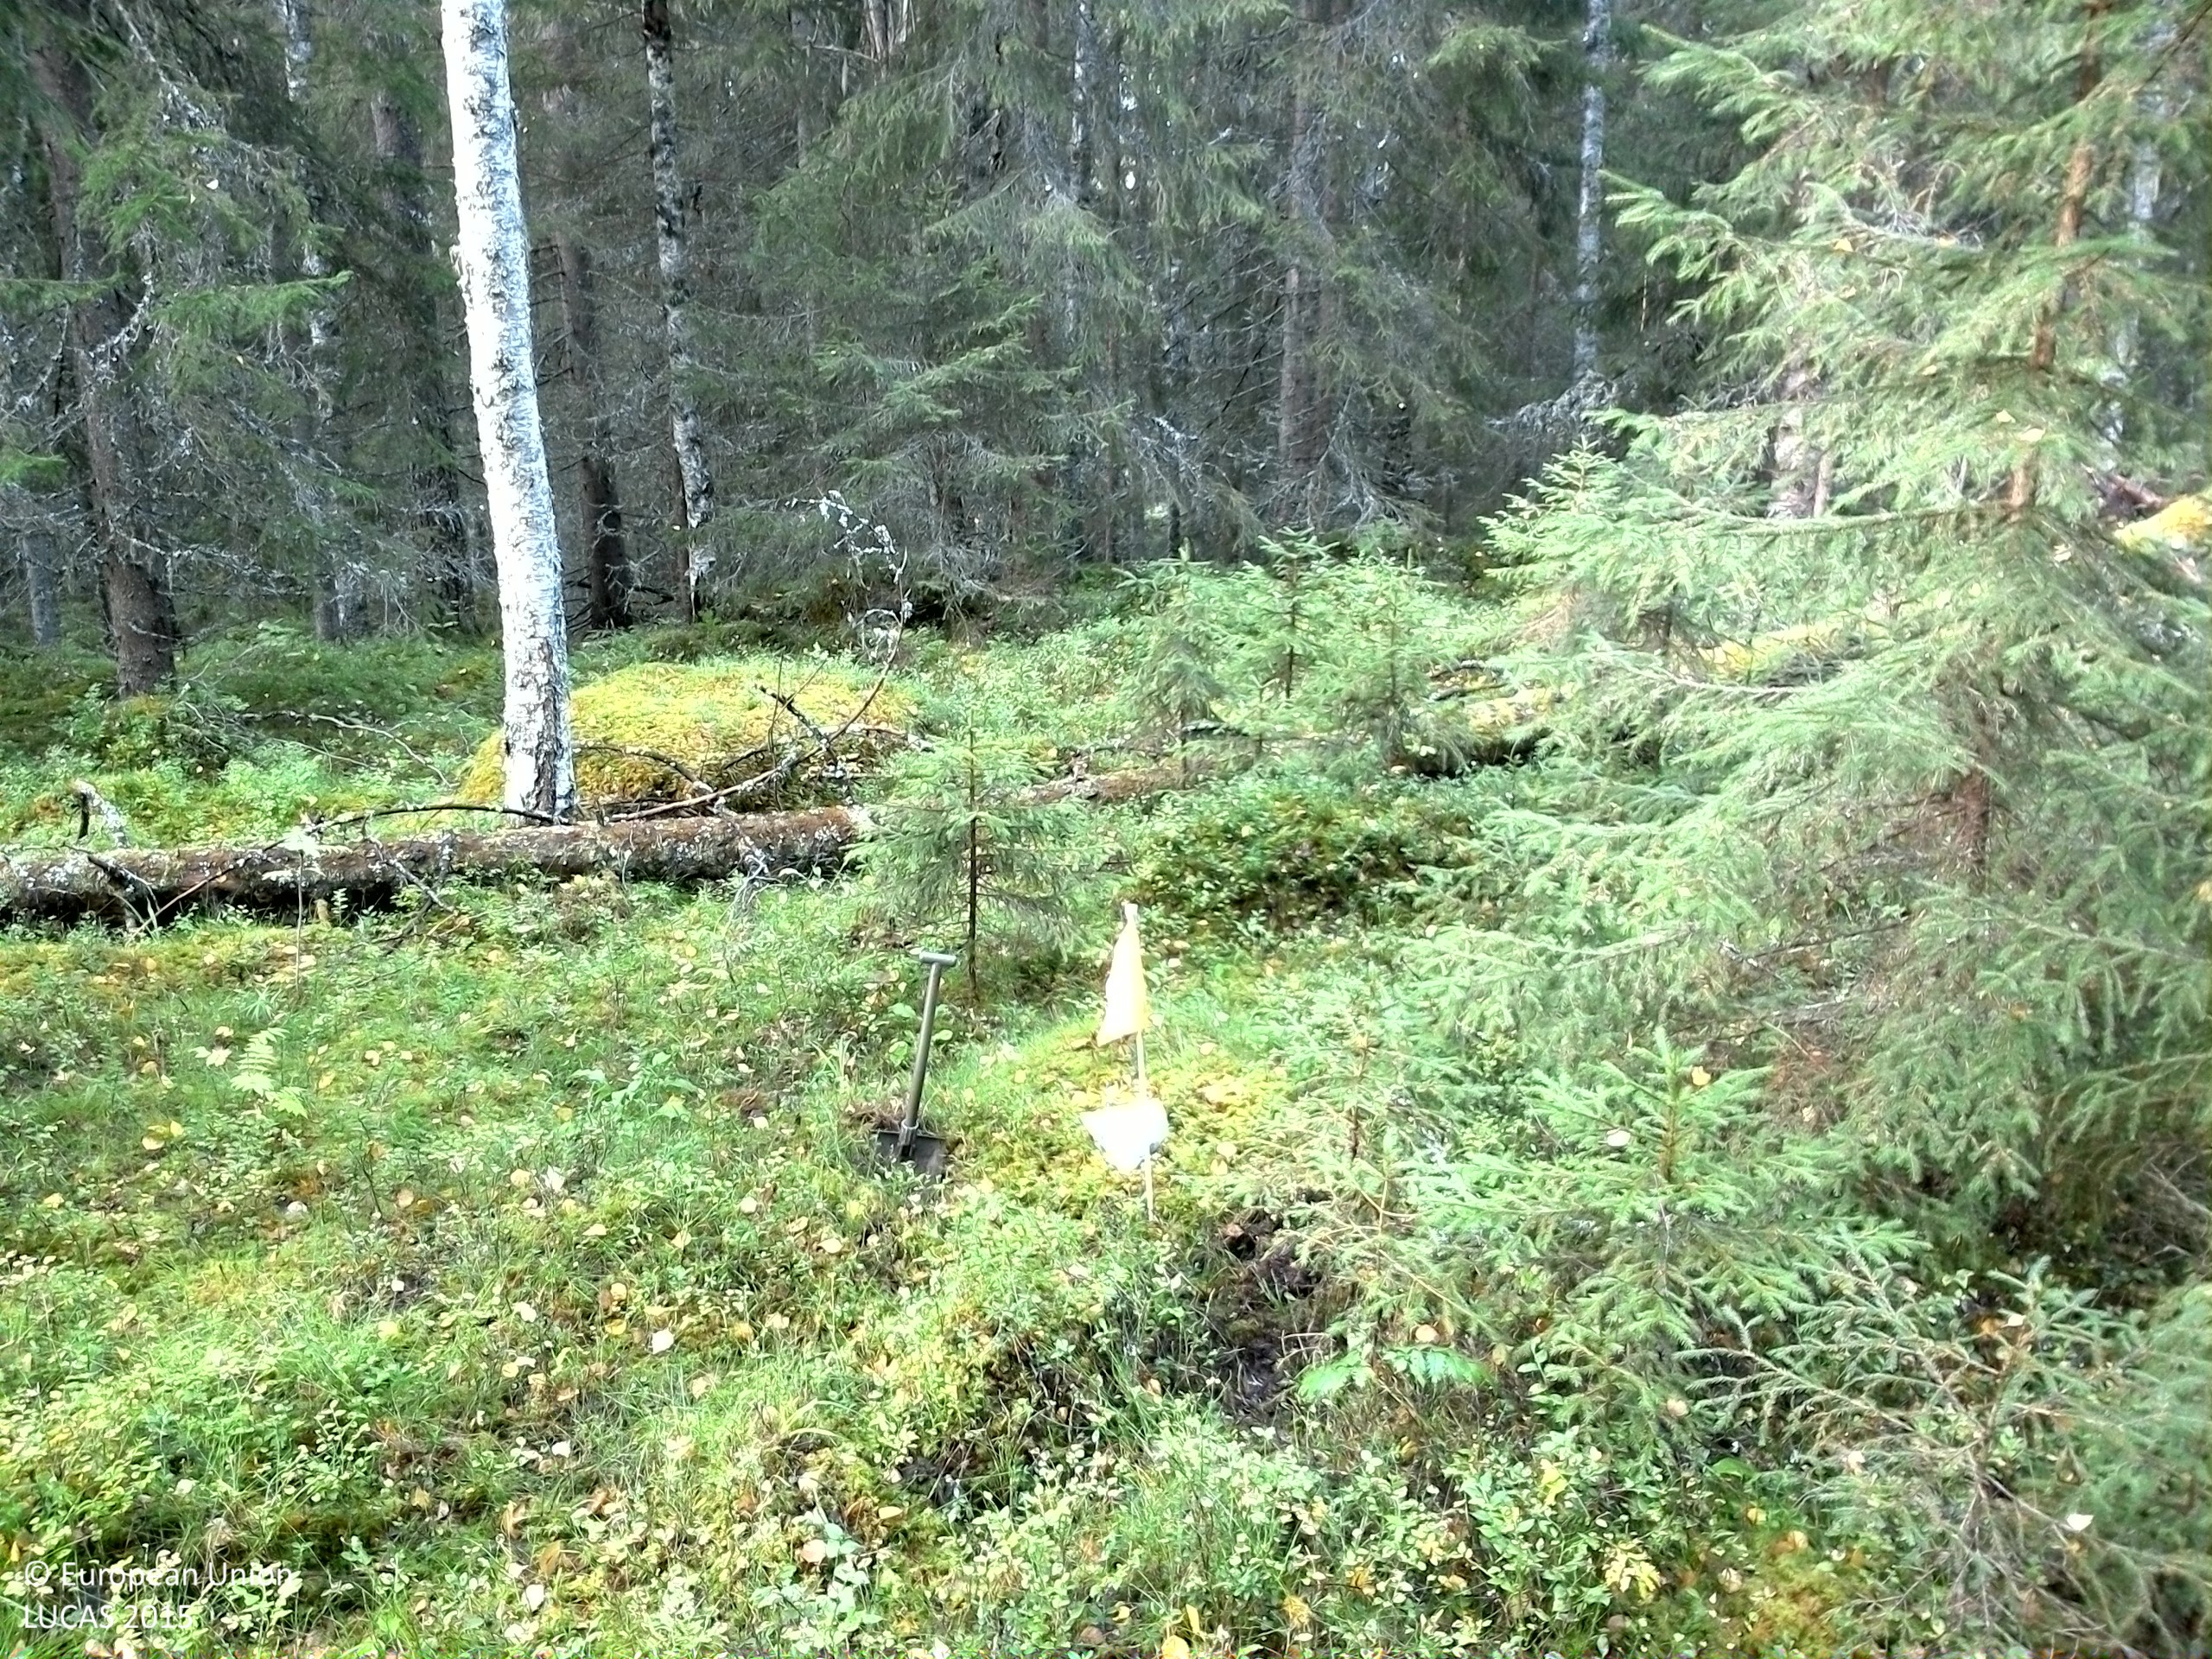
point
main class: Woodland
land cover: Spruce dominated mixed woodland
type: boreal forest
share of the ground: 50 - 75 %
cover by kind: coniferous forest trees 45 %, shrubs 25 %, broadleaved forest trees 15 %, lichens and mosses 15 %
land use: Forestry
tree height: > 5 m
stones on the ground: 10 - 25 %
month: September
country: SE
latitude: 61.3443
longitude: 15.3123
